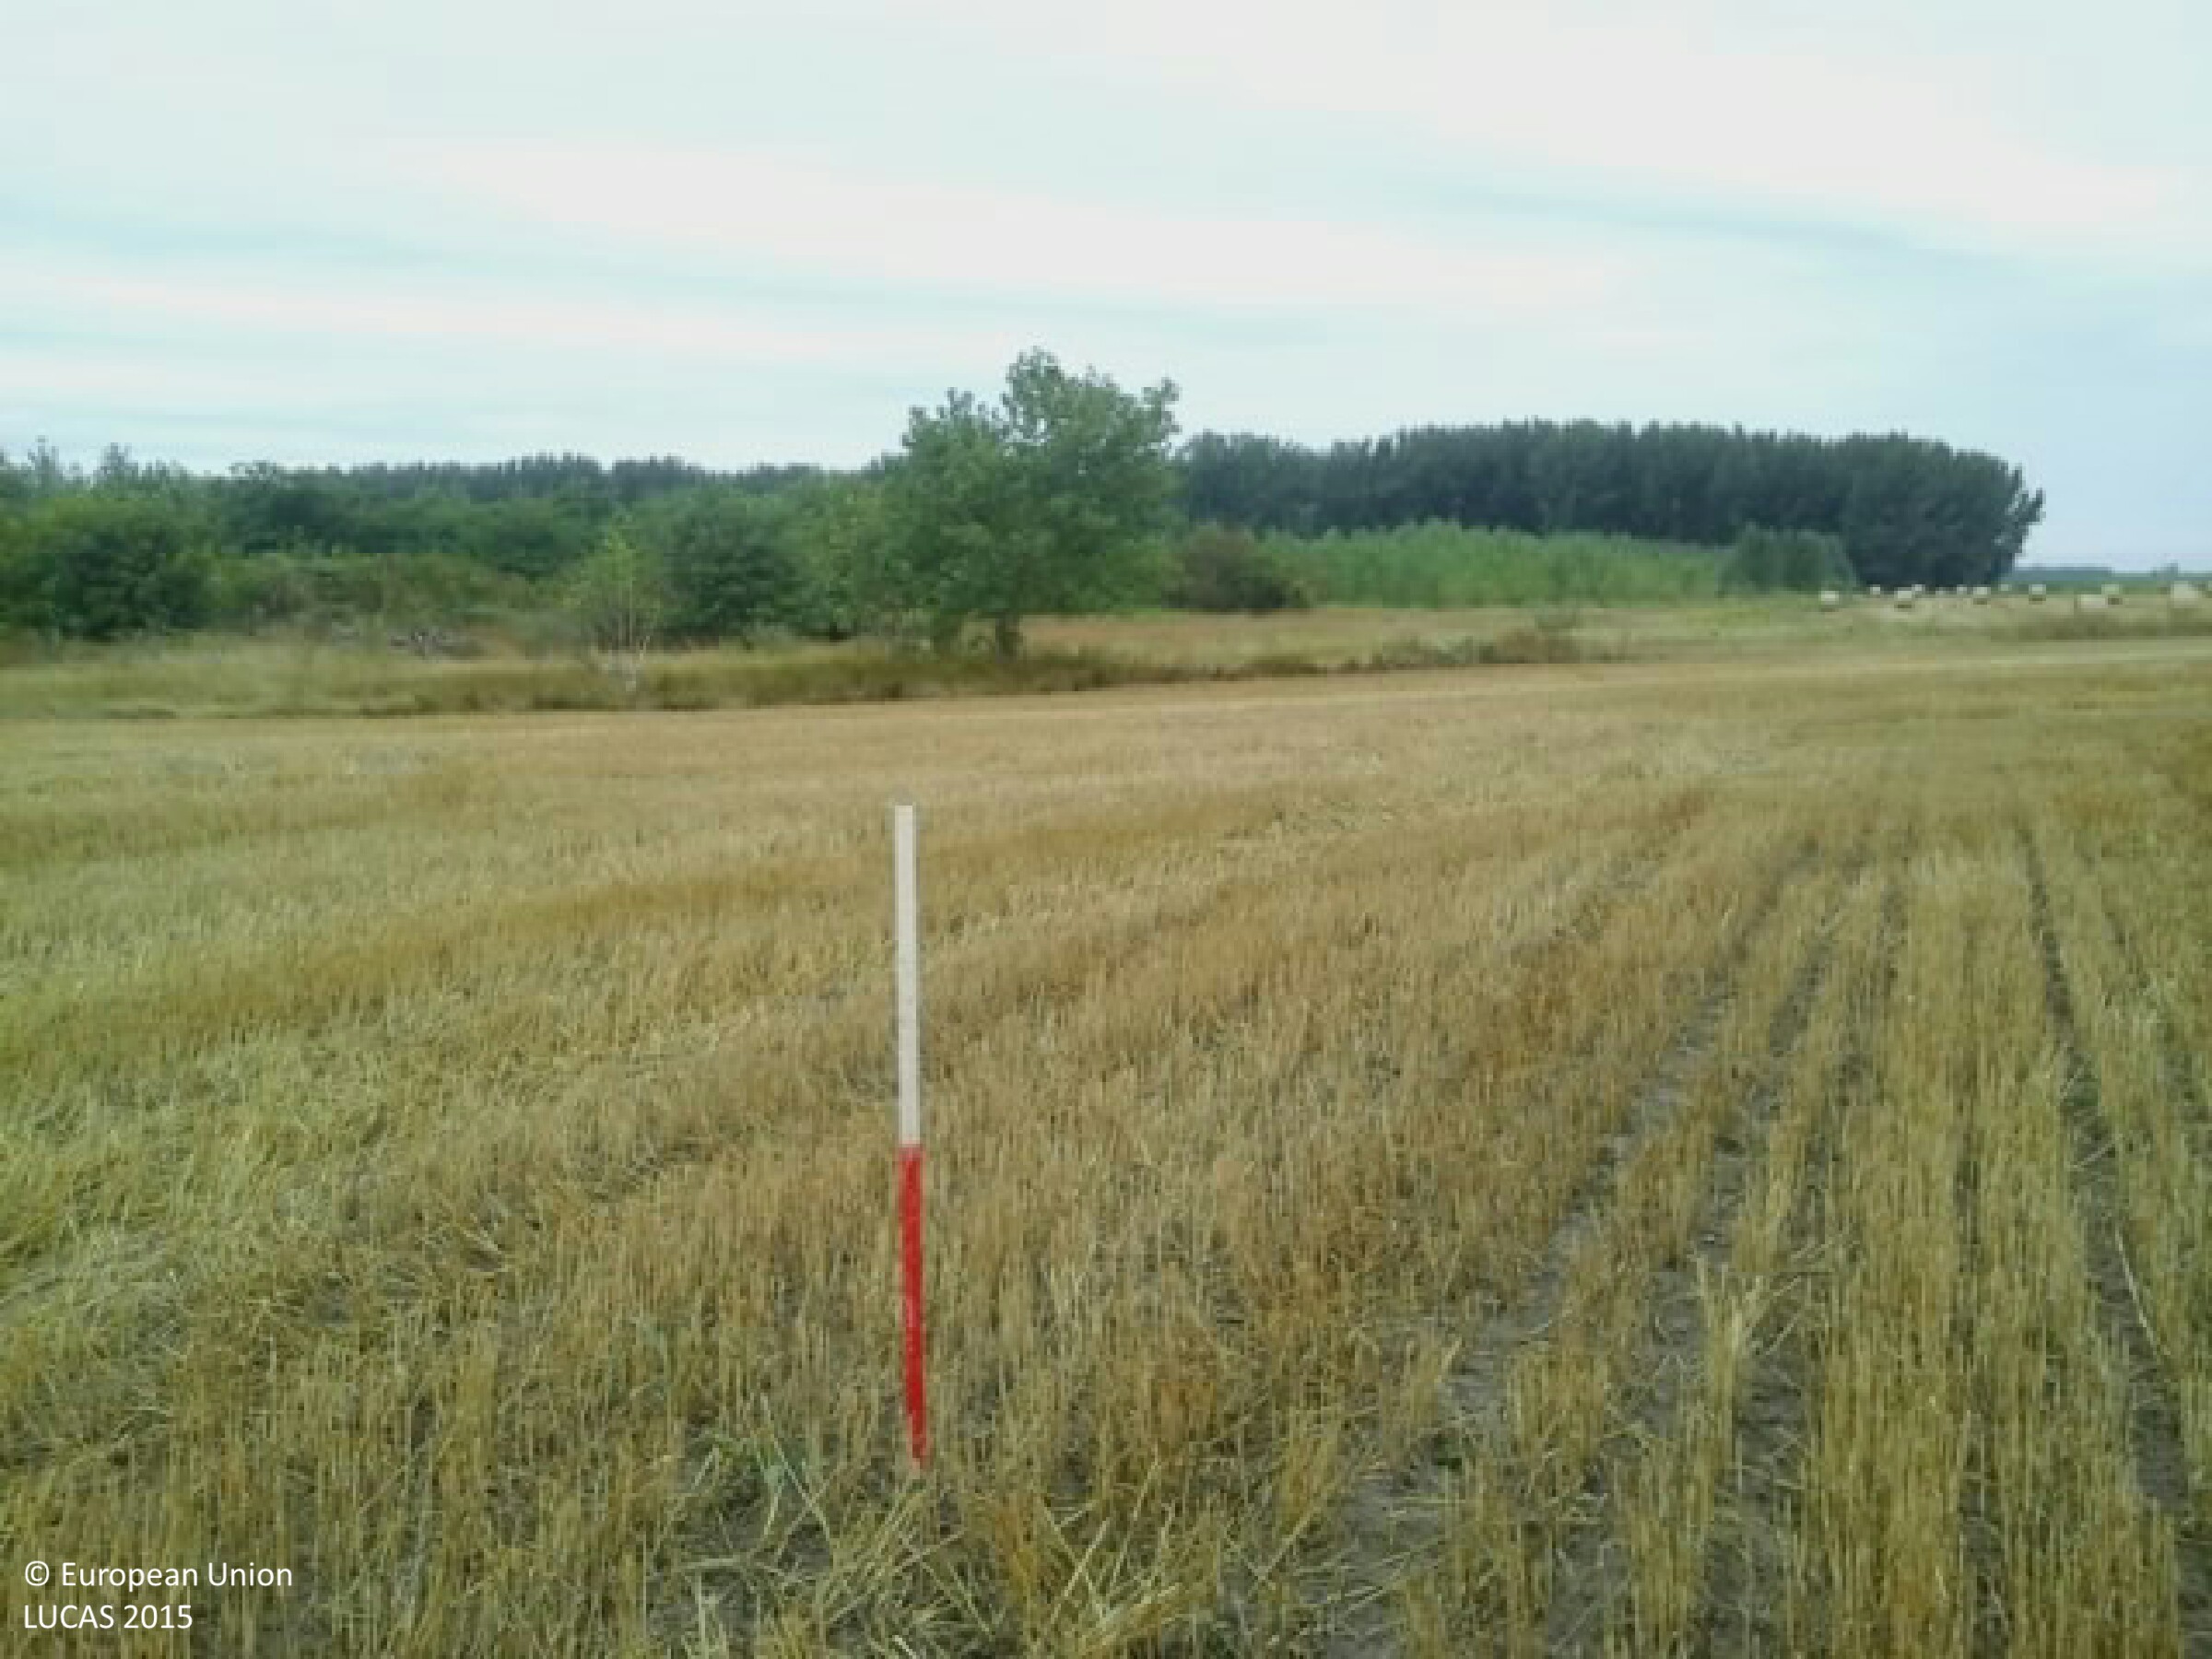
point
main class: Cropland
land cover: Common wheat
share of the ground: 25 - 50 %
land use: Agriculture (excluding fallow land and kitchen gardens)
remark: Harvested field
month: July
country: HU
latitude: 46.9534
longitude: 19.7846
